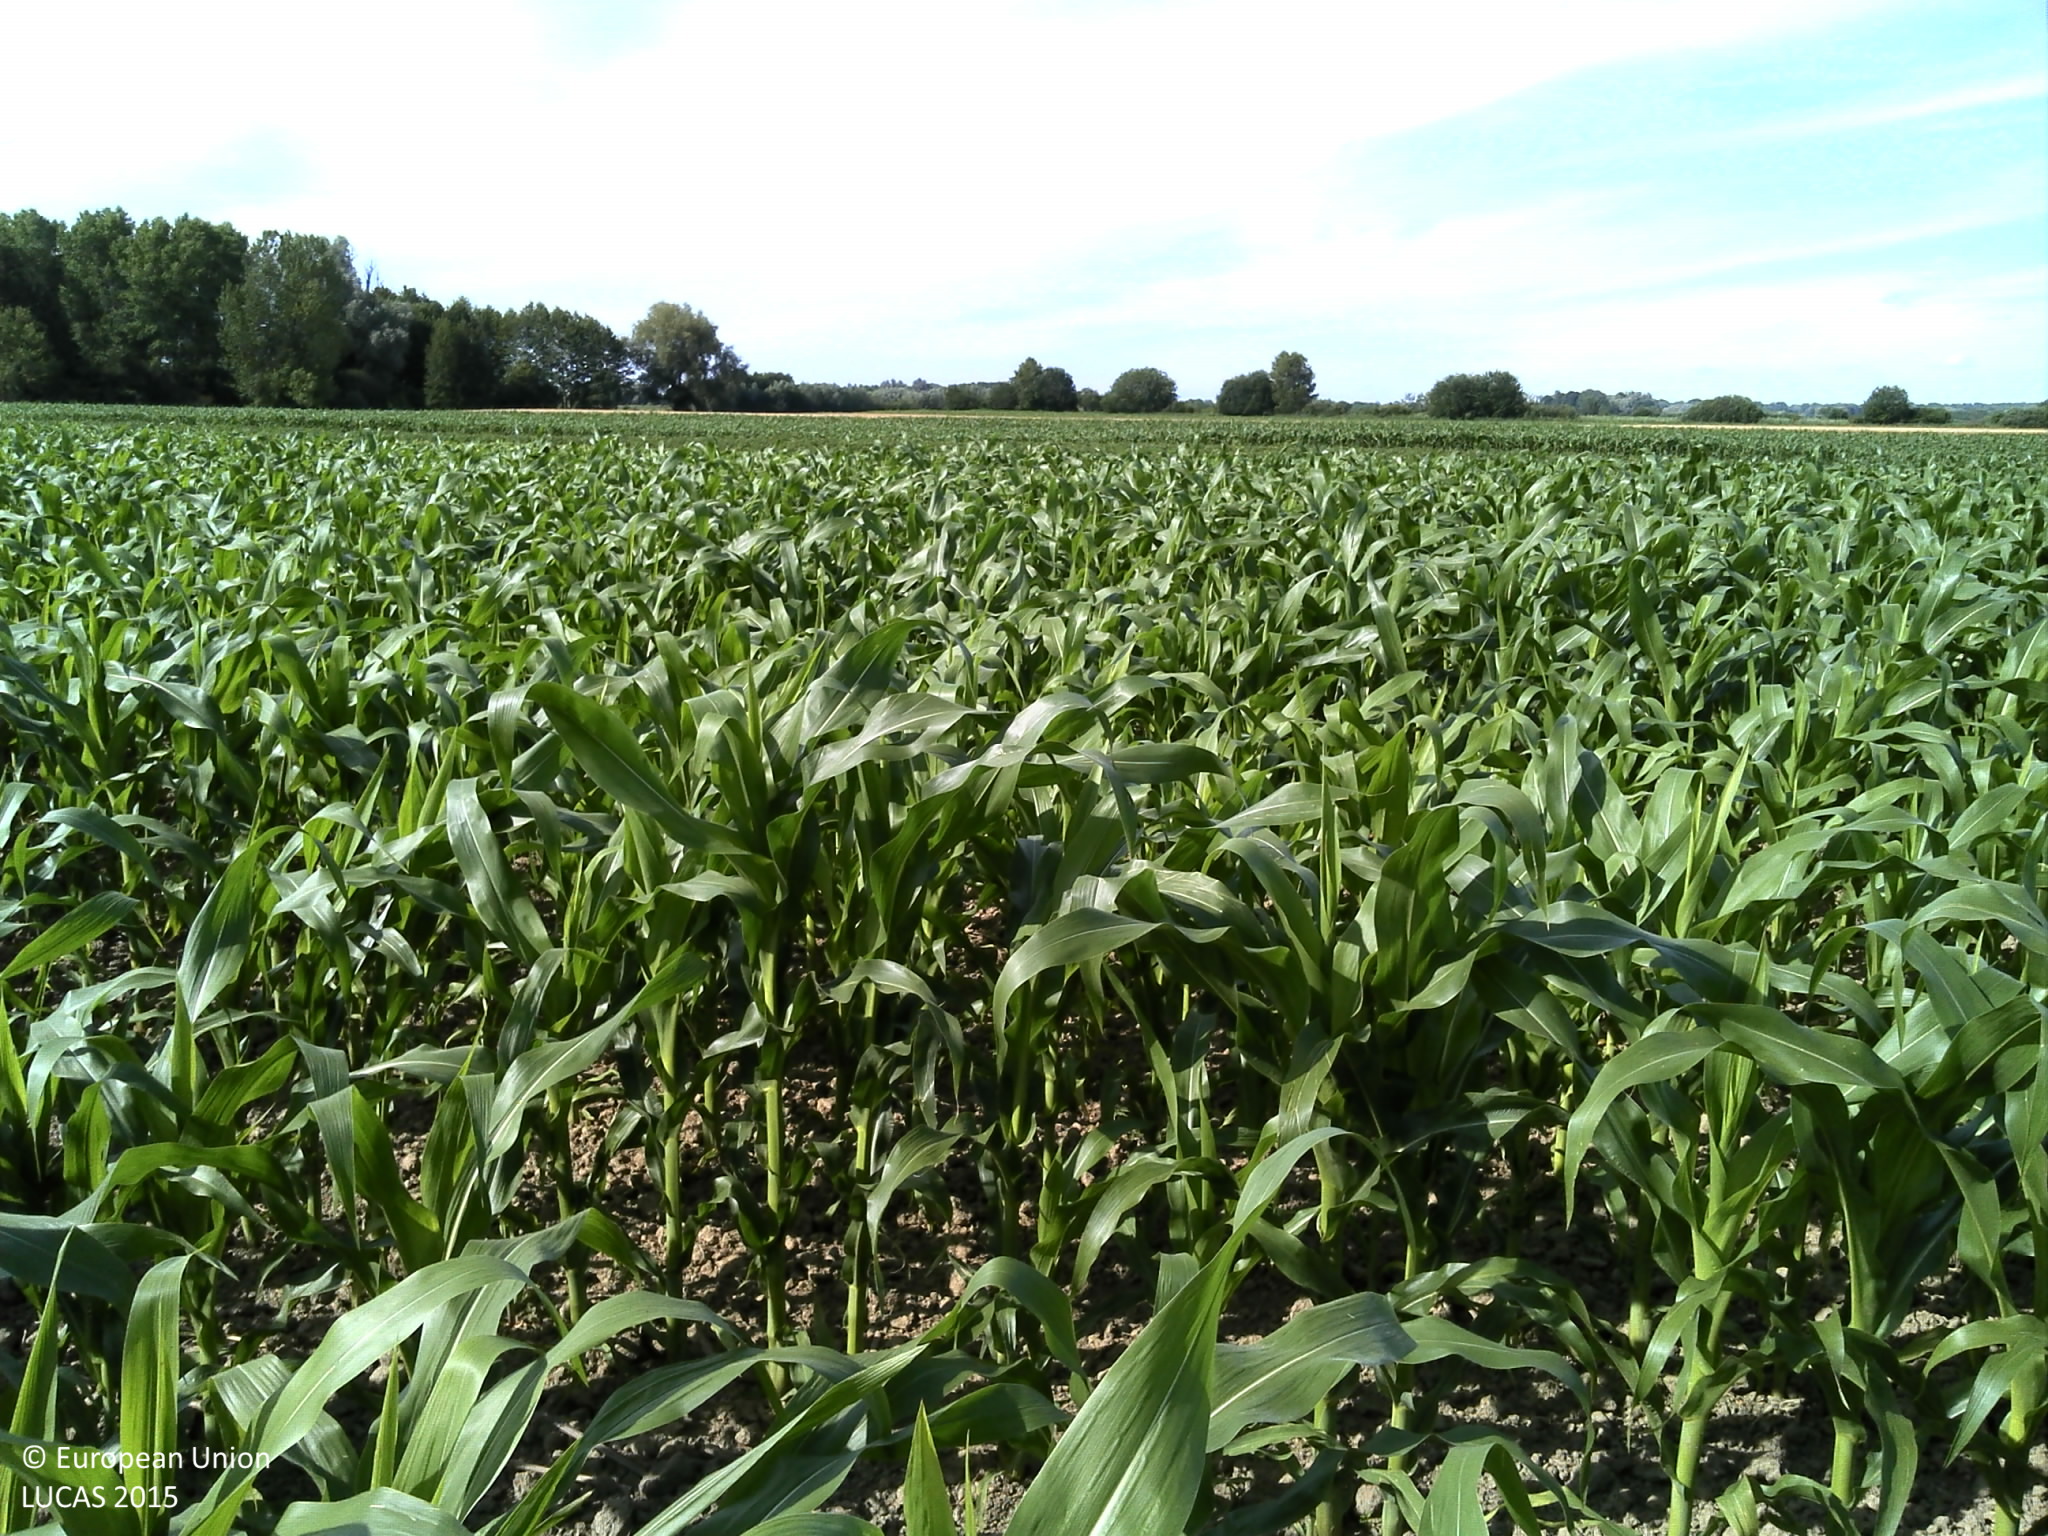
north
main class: Cropland
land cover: Maize
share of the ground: > 75 %
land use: Agriculture (excluding fallow land and kitchen gardens)
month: June
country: HR
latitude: 45.9037
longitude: 17.5438
